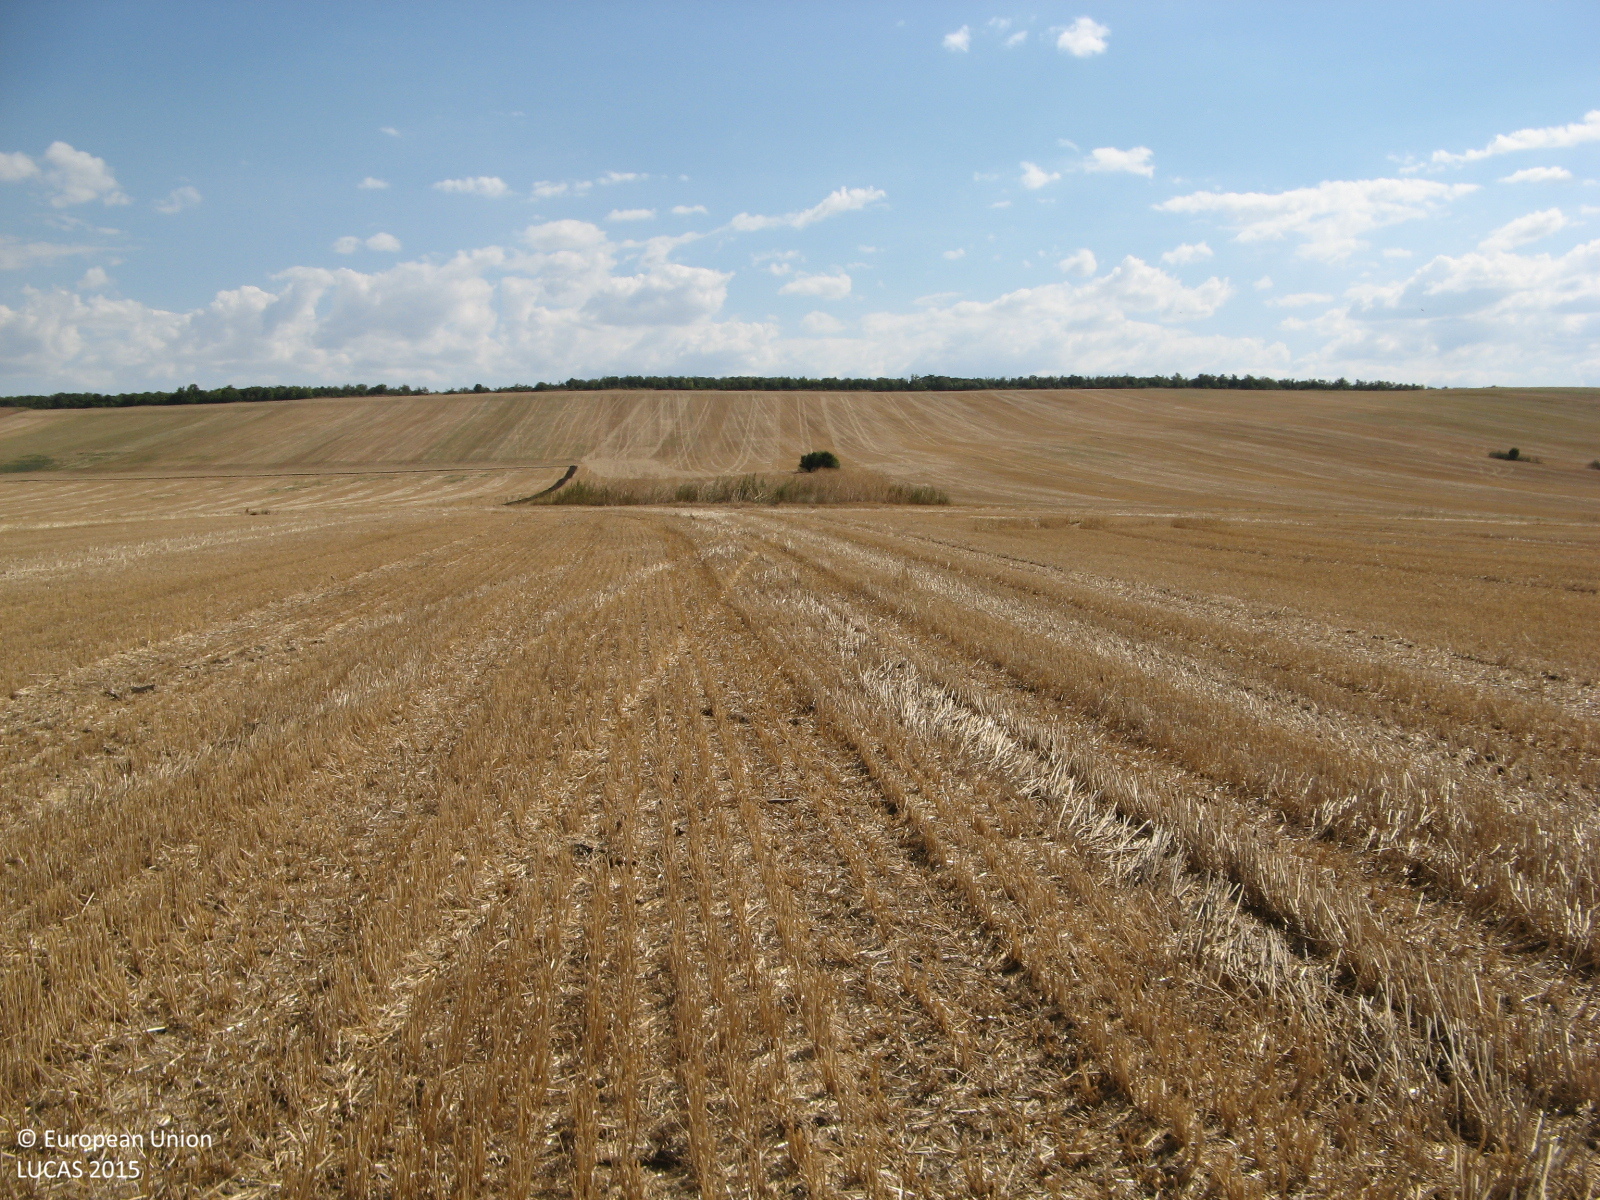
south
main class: Cropland
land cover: Common wheat
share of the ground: 50 - 75 %
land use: Agriculture (excluding fallow land and kitchen gardens)
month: August
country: BG
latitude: 43.4297
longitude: 25.4091
